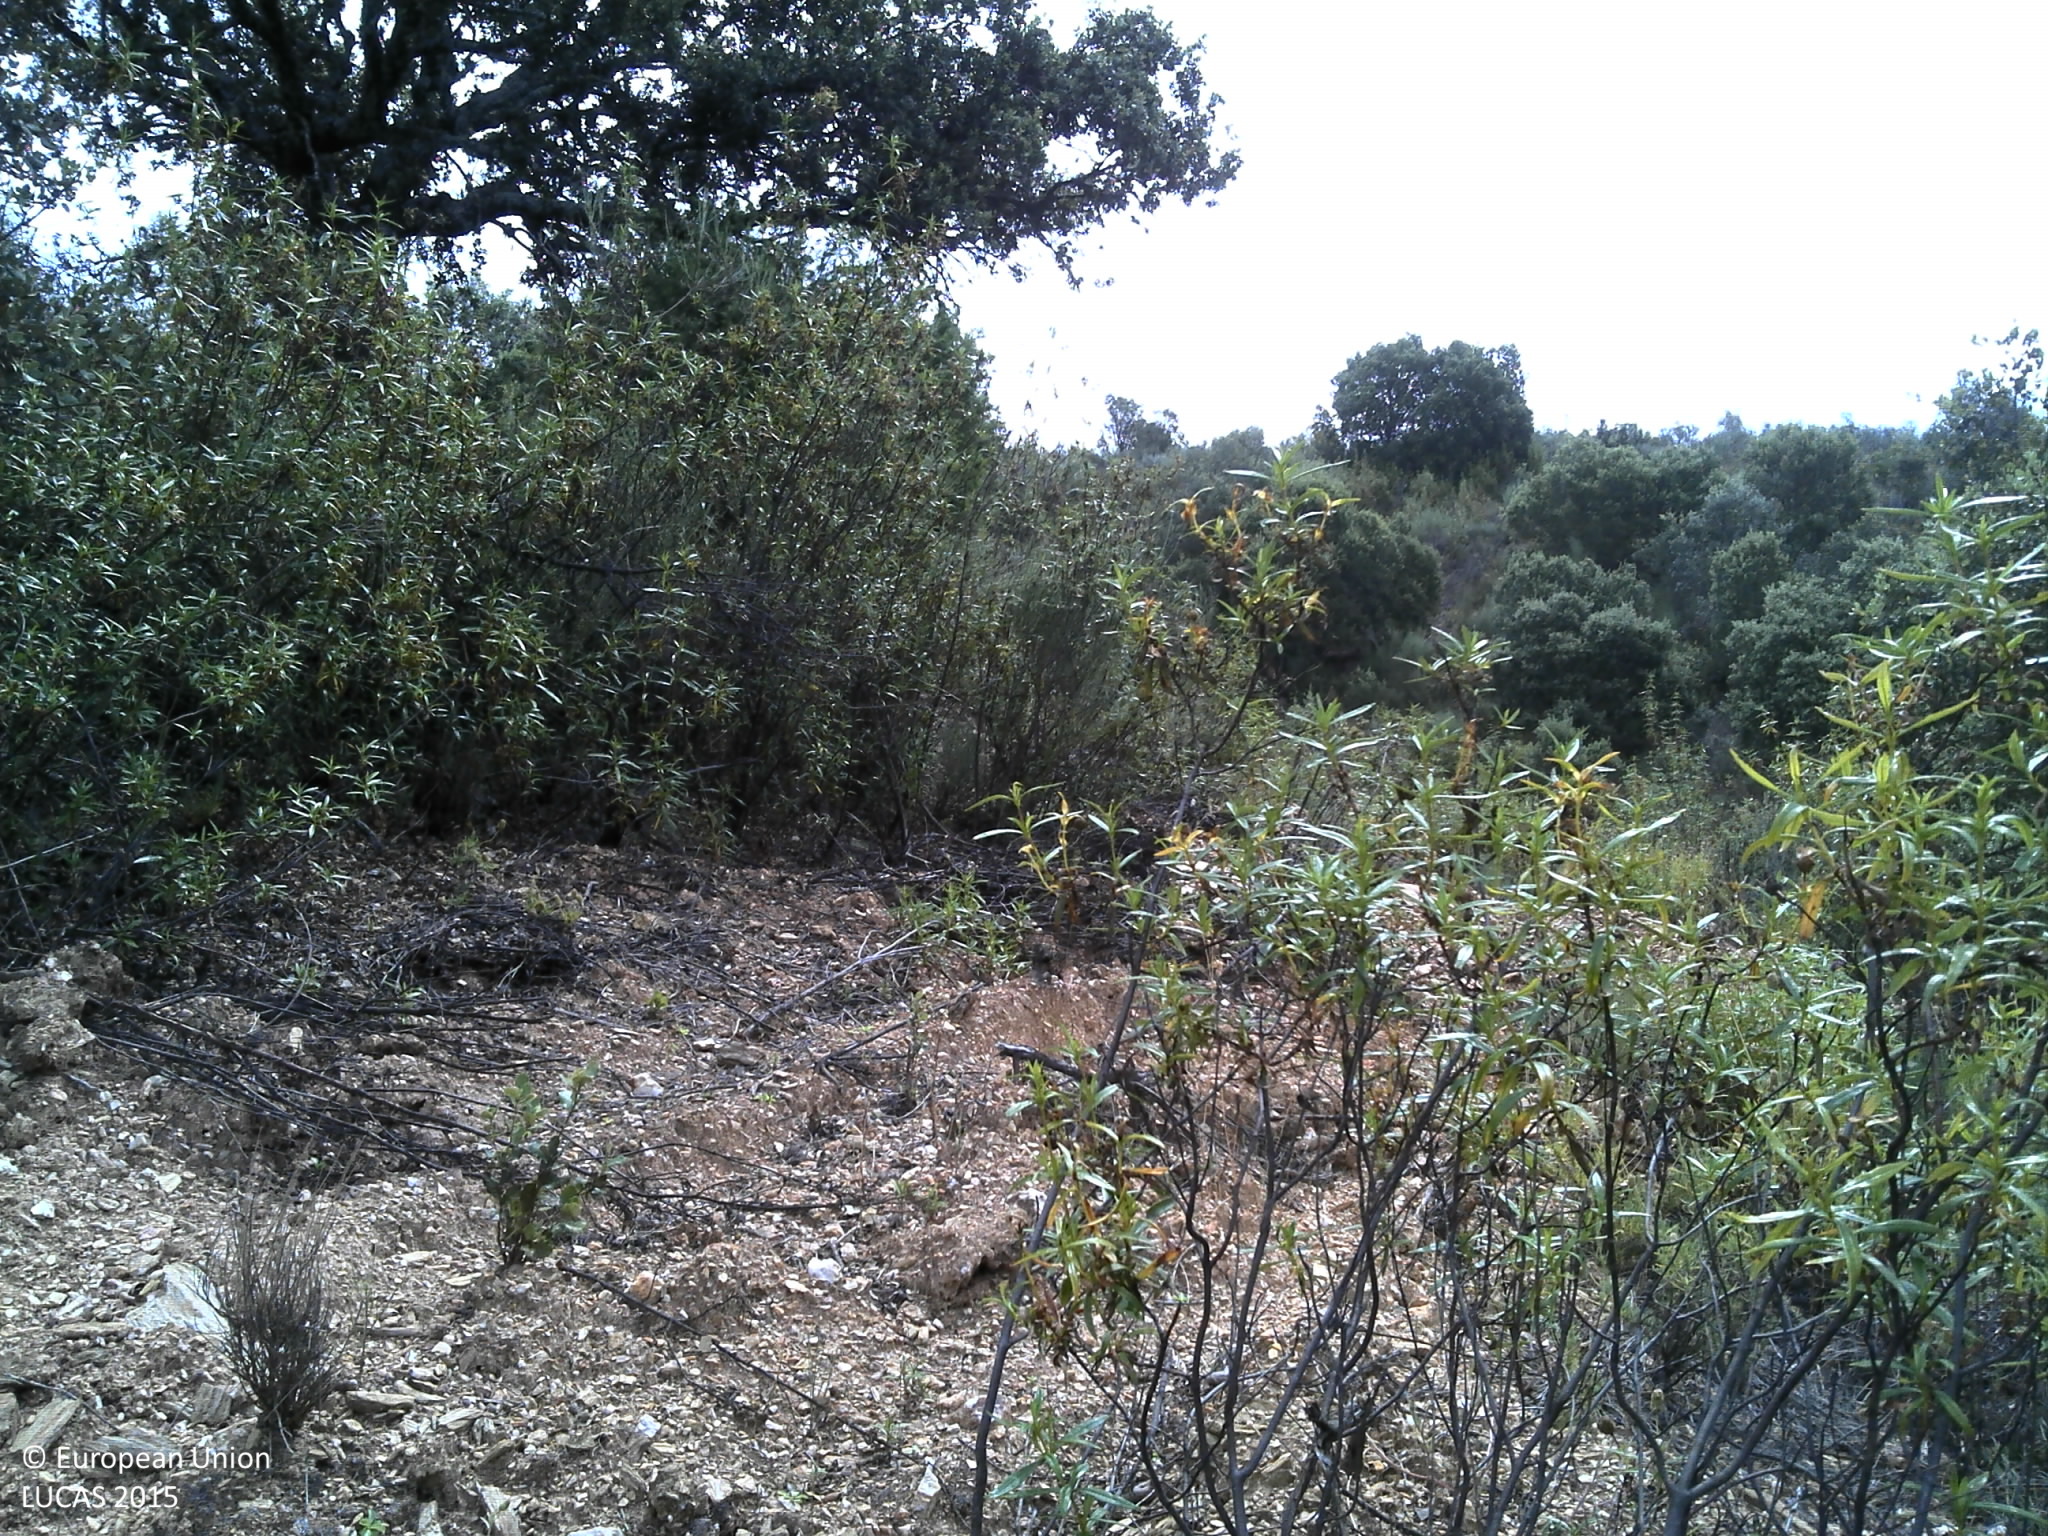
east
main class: Woodland
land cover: Broadleaved woodland
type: broadleaved evergreen forest
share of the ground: 10 - 25 %
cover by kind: shrubs 70 %, unconsolidated bare surface 20 %, broadleaved forest trees 10 %
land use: Semi-natural and natural areas not in use
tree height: > 5 m
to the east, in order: Broadleaved woodland; Shrubland with sparse tree cover; Fences; Grassland with sparse tree/shrub cover; Grassland without tree/shrub cover; Broadleaved woodland; Lines of trees; Grassland without tree/shrub cover; Lines of trees; Rivers and streams
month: June
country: PT
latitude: 41.3854
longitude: -6.9123
